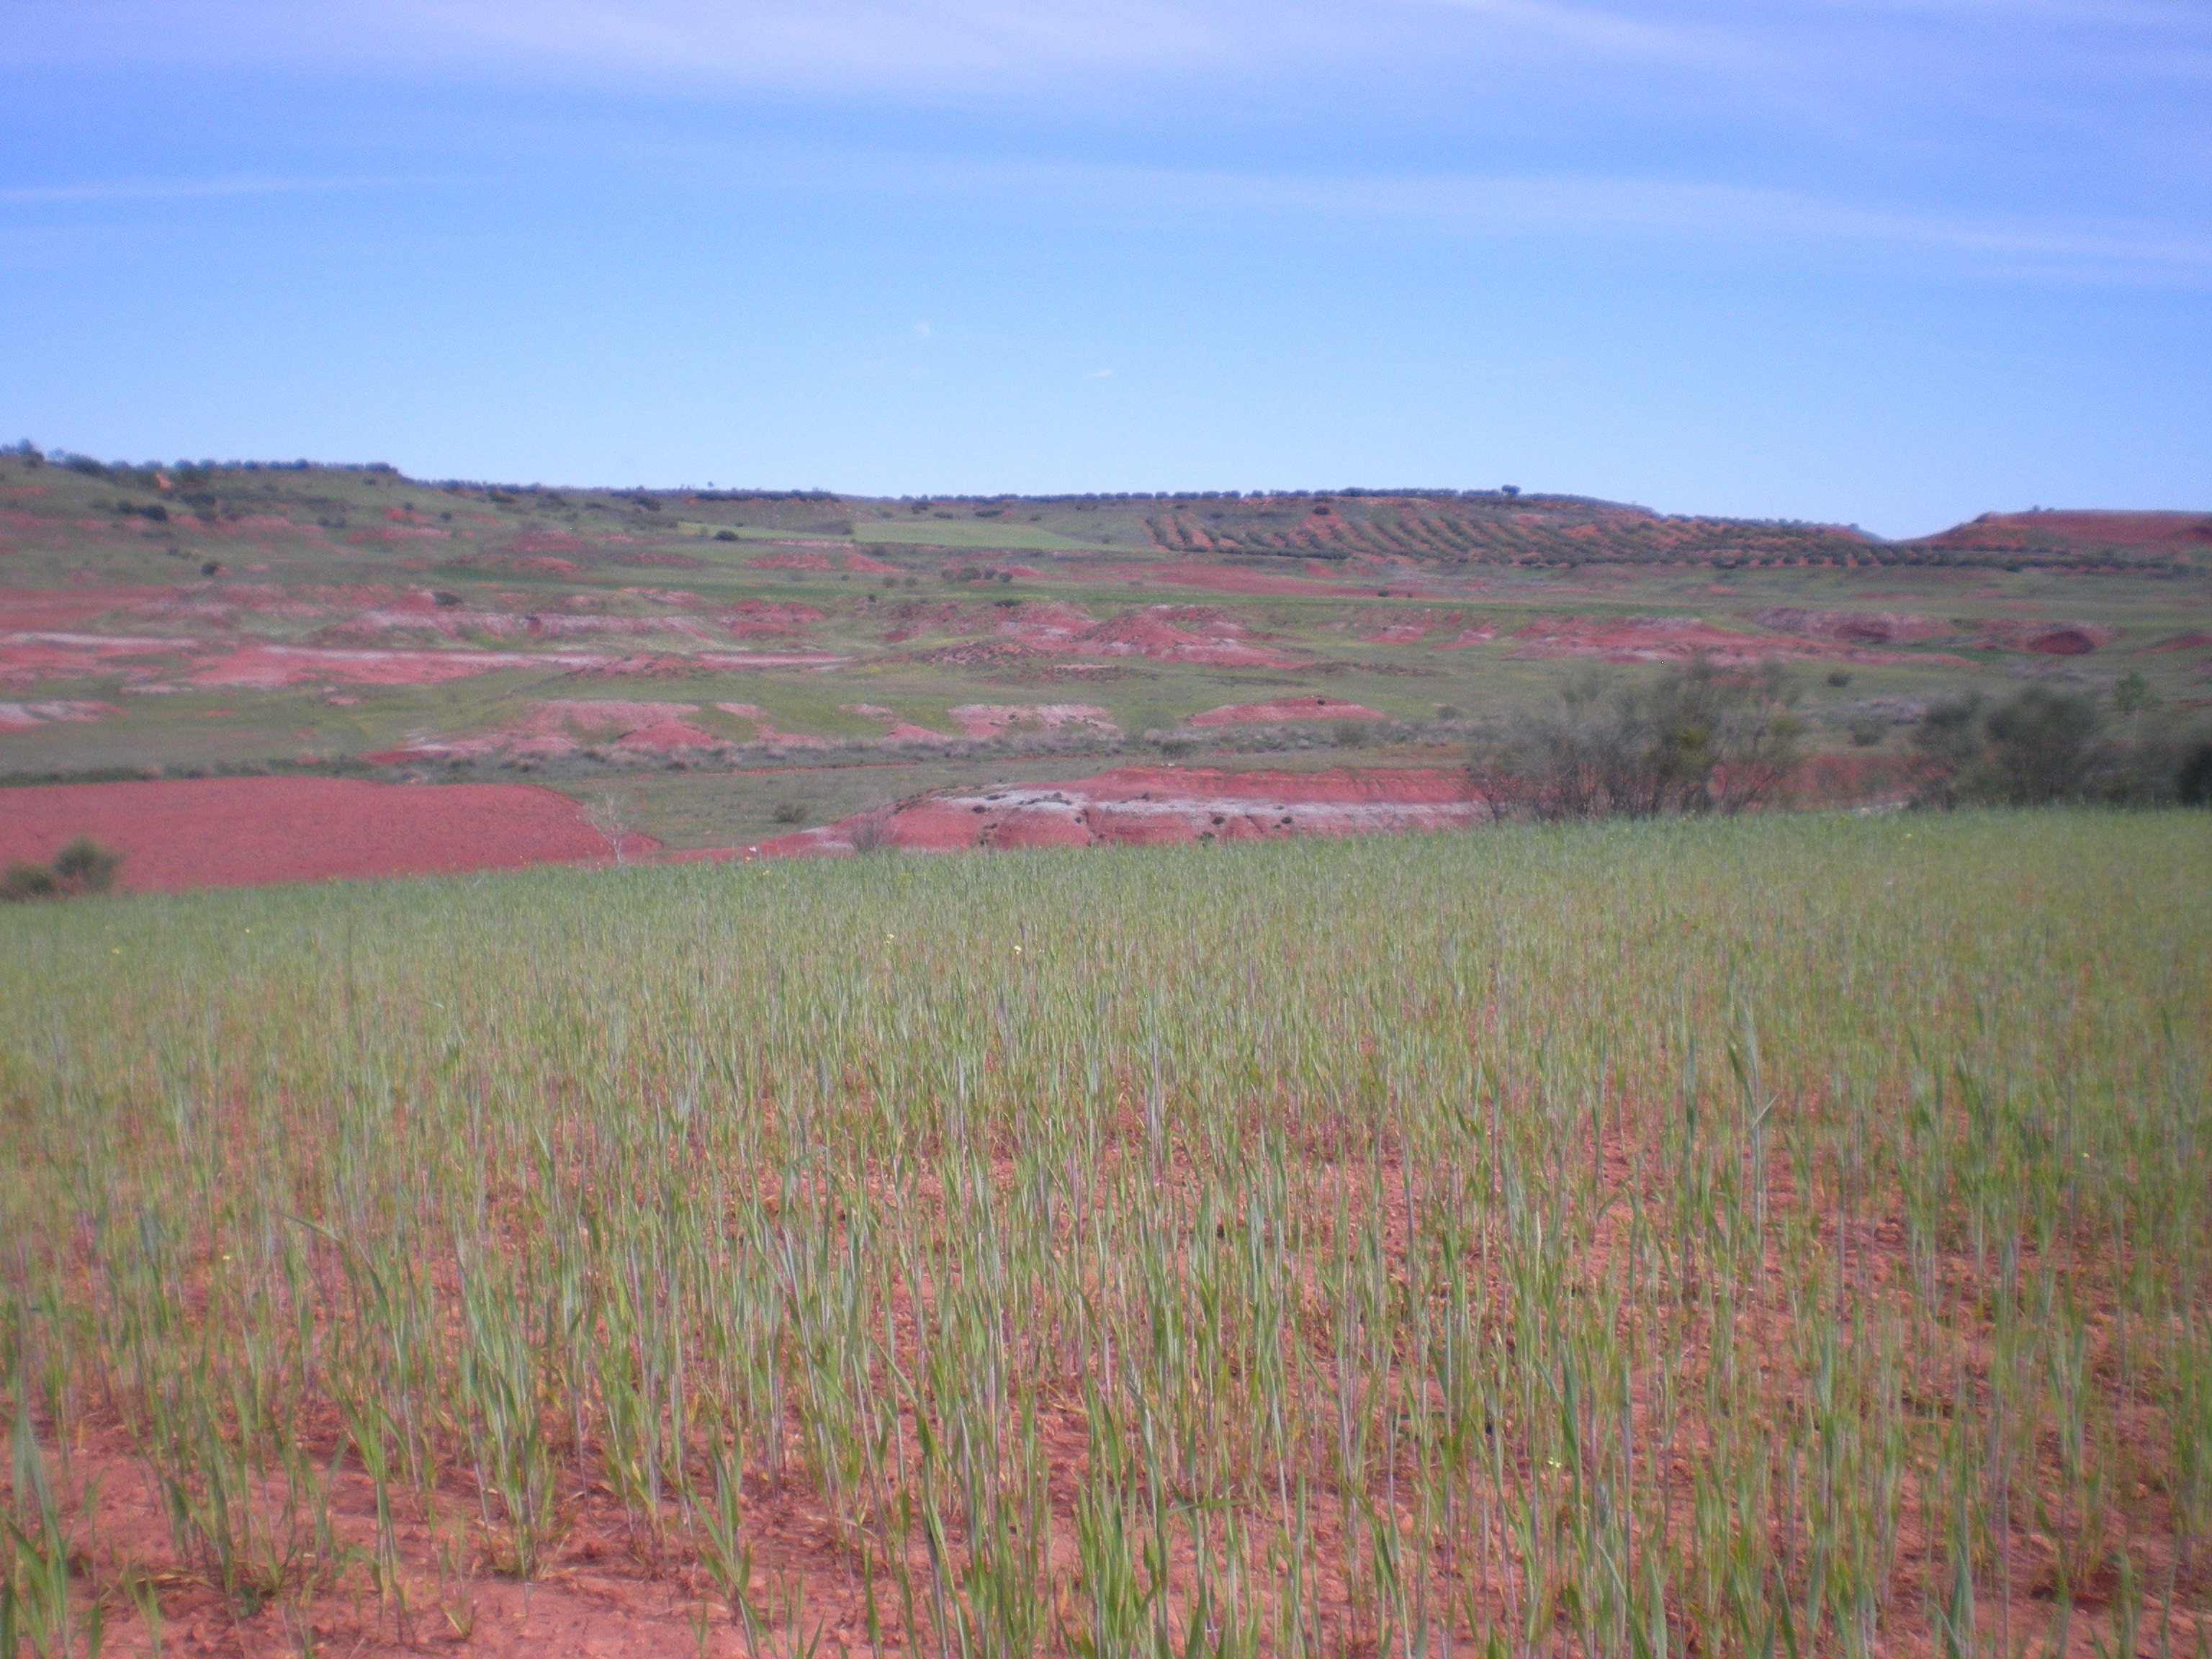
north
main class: Cropland
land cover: Durum wheat
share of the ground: 50 - 75 %
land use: Agriculture (excluding fallow land and kitchen gardens)
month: April
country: ES
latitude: 38.6150
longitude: -2.9710
